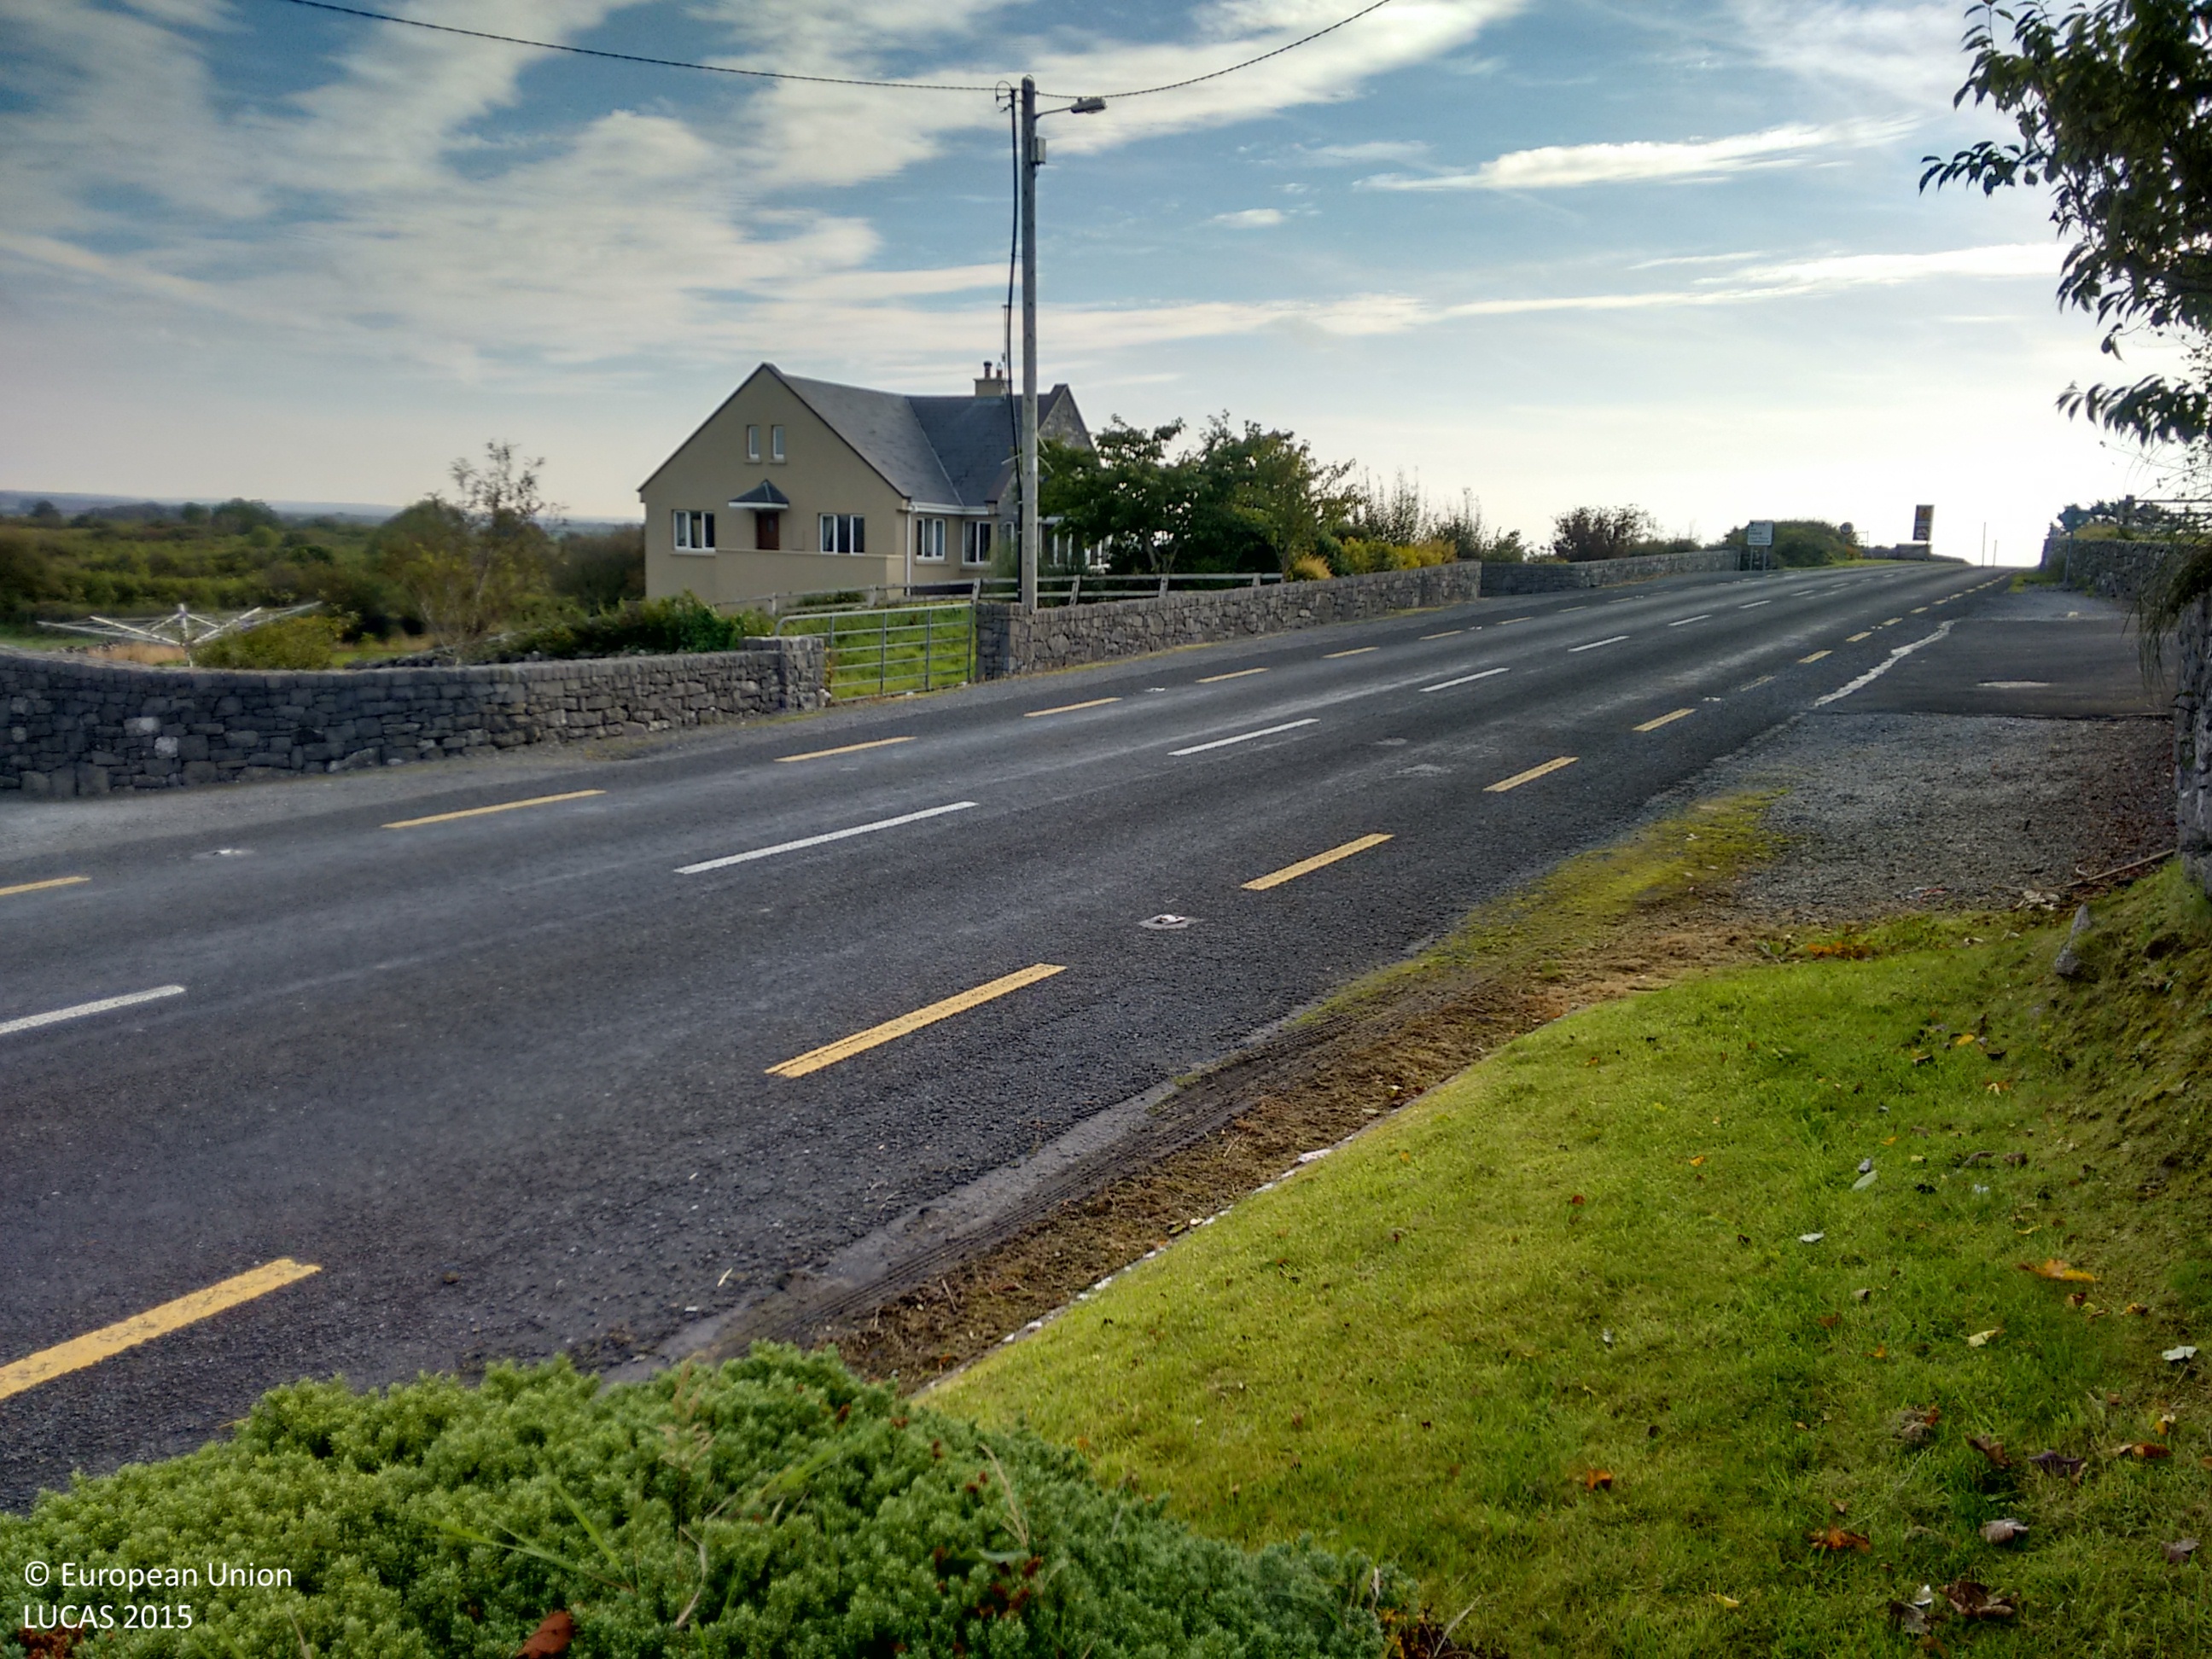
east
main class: Grassland
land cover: Grassland without tree/shrub cover
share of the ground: > 75 %
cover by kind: herbaceous plants 100 %
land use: Agriculture (excluding fallow land and kitchen gardens)
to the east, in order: Grassland without tree/shrub cover; Fences; Dry stone walls; Grassland without tree/shrub cover; Dry stone walls; Fences; Grassland without tree/shrub cover
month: September
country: IE
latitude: 52.9890
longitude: -9.2148
